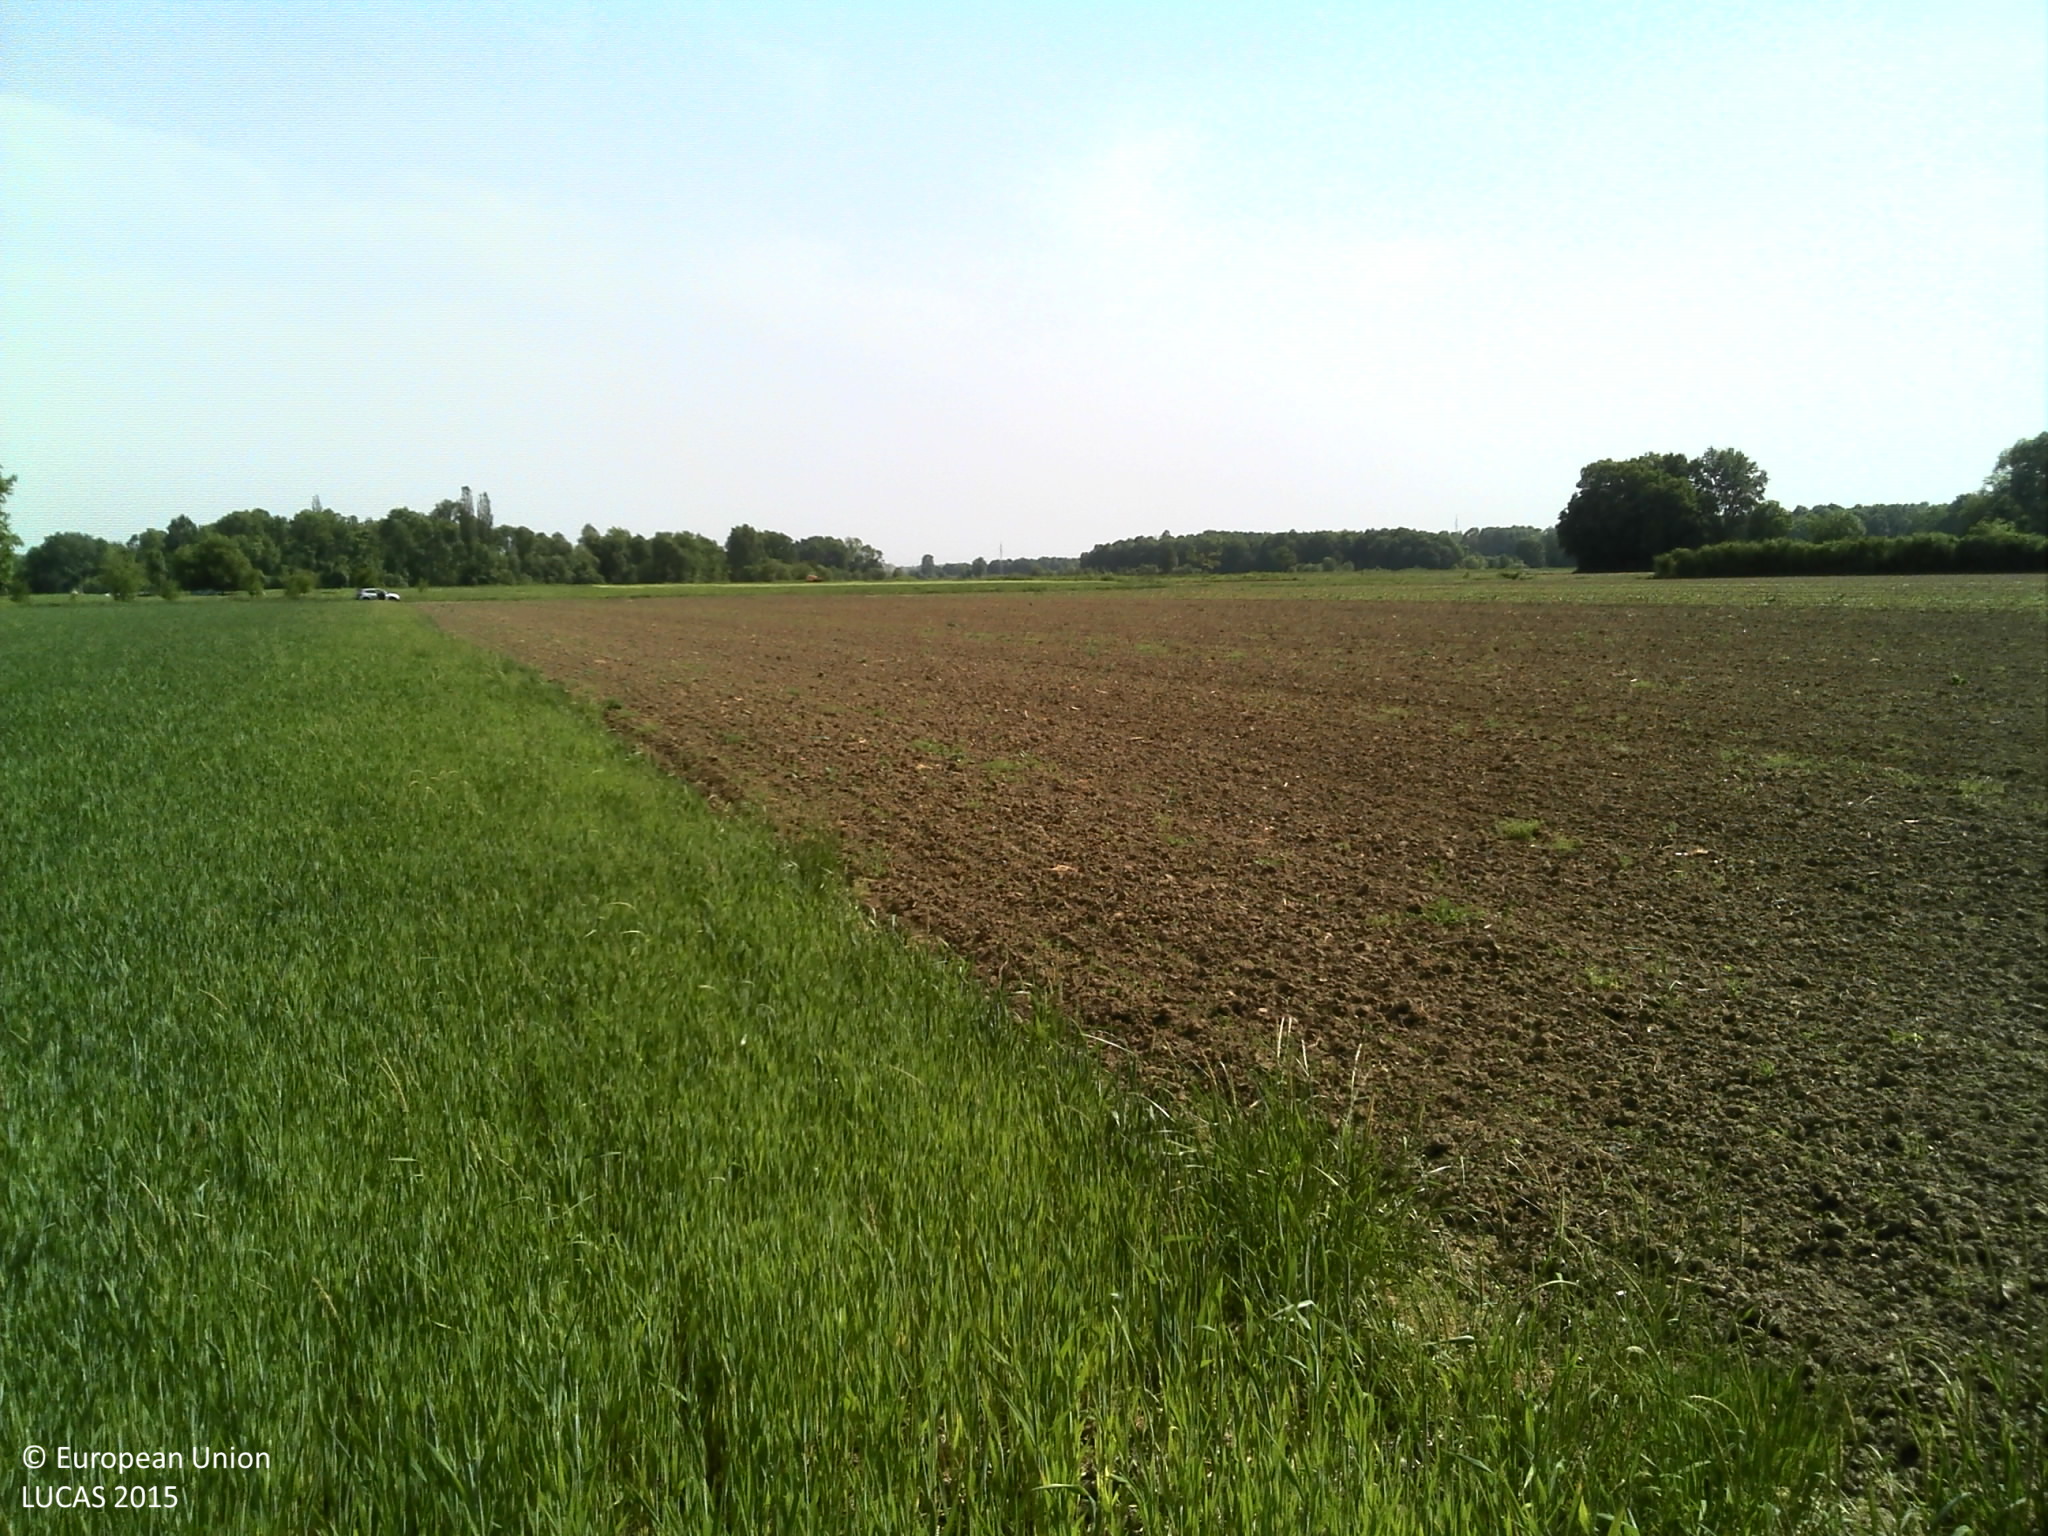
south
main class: Cropland
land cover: Common wheat
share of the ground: > 75 %
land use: Agriculture (excluding fallow land and kitchen gardens)
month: May
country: HR
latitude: 45.1640
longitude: 18.4650
